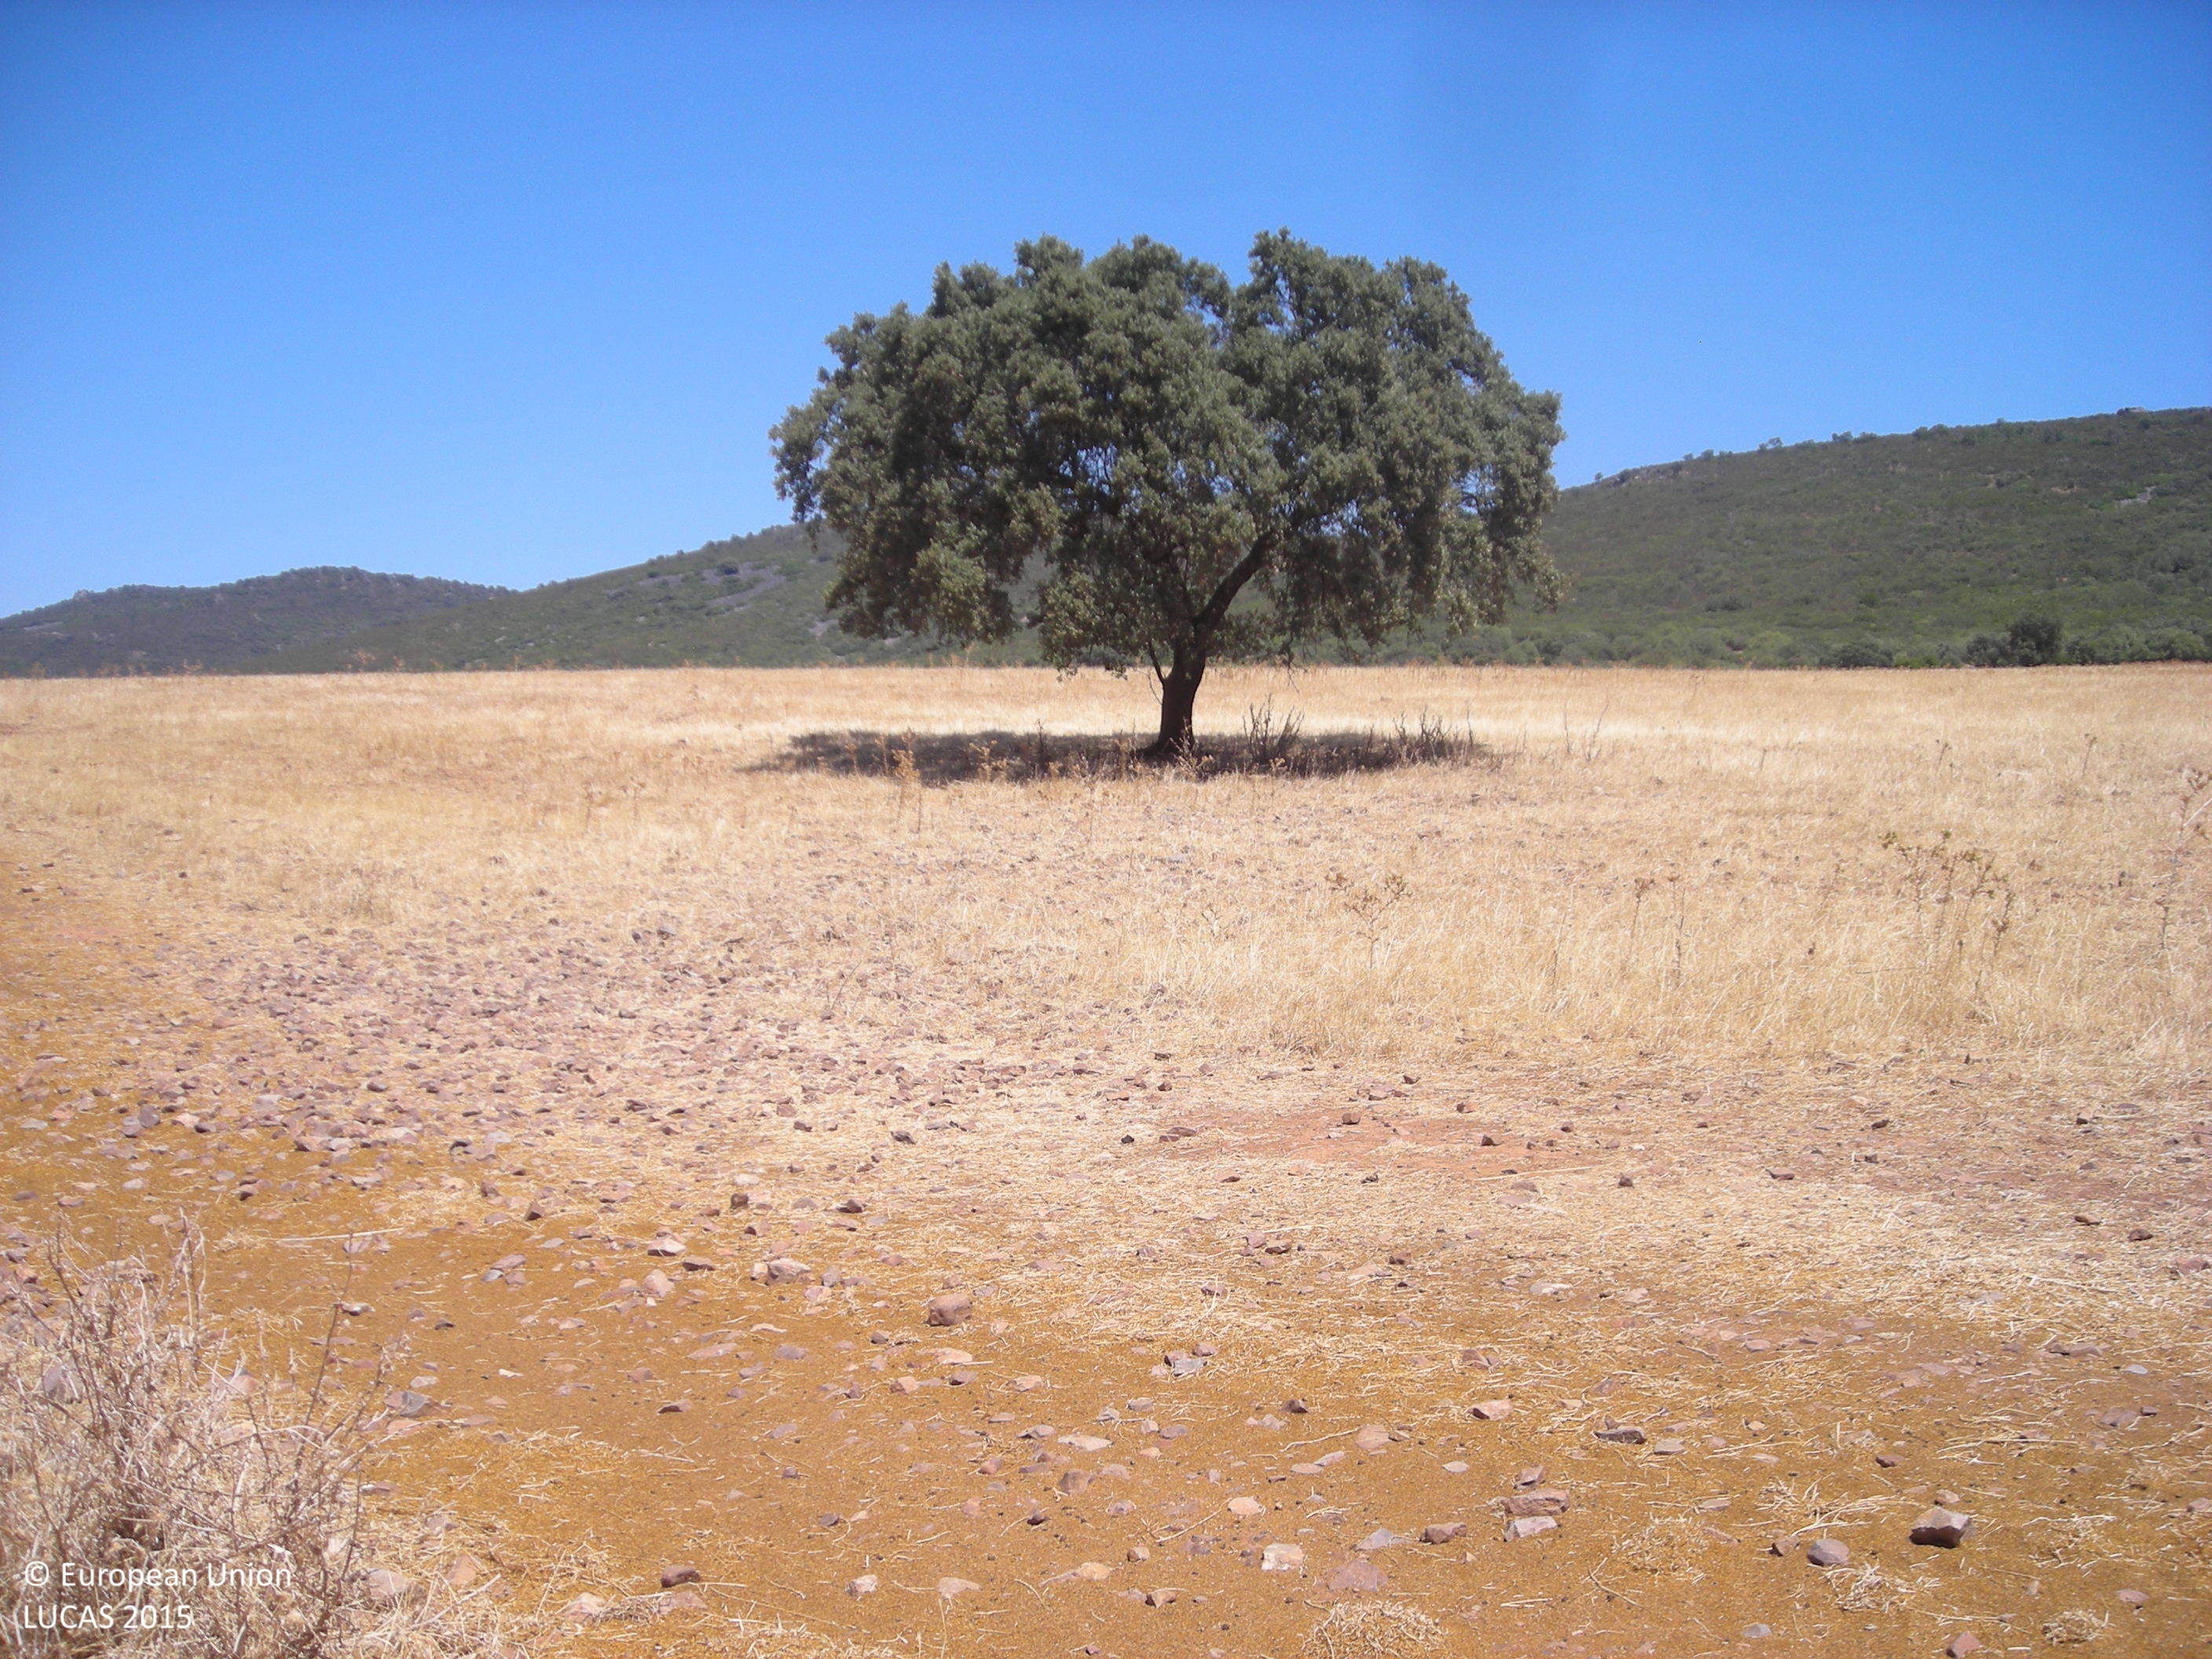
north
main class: Grassland
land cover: Grassland with sparse tree/shrub cover
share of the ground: > 75 %
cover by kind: herbaceous plants 85 %, shrubs 10 %, broadleaved forest trees 5 %
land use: Agriculture (excluding fallow land and kitchen gardens)
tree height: > 5 m
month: July
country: ES
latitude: 38.7032
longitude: -5.9026
